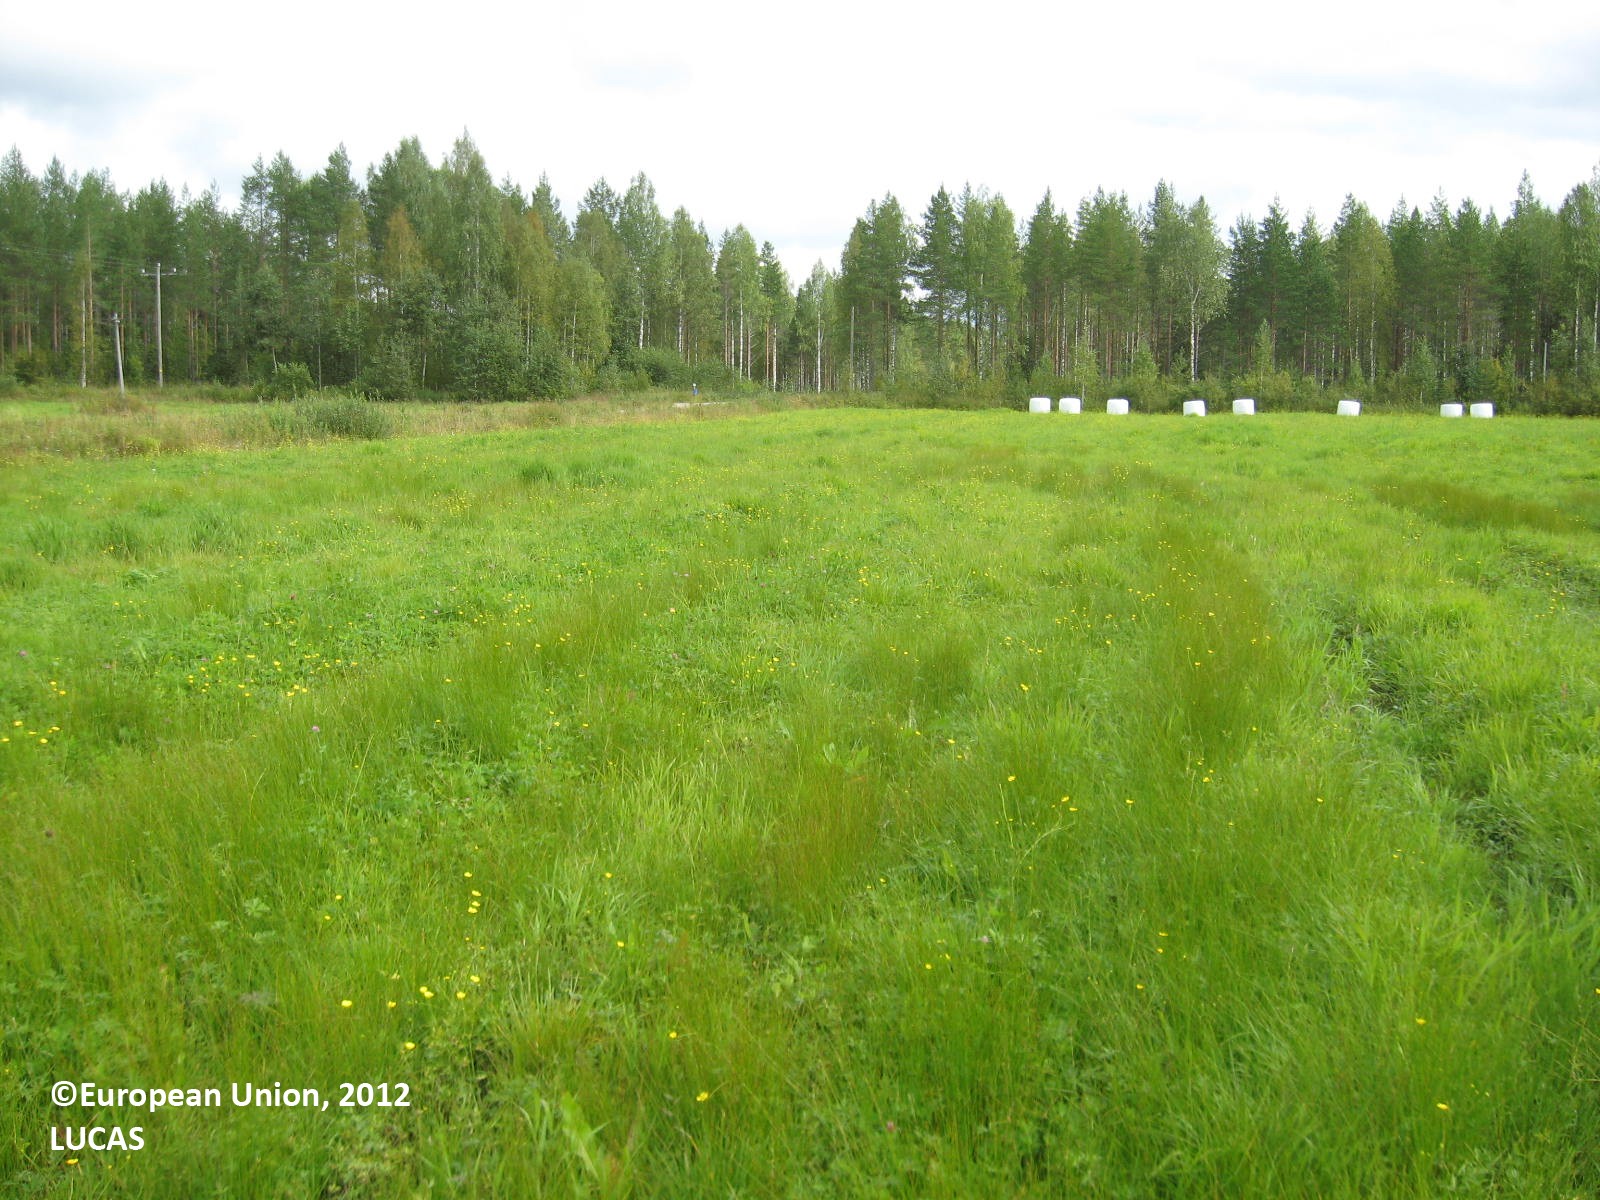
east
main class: Cropland
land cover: Temporary grasslands
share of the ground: > 75 %
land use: Agriculture (excluding fallow land and kitchen gardens)
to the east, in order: Temporary grasslands; Grass margins; Shruby margins; Paved roads, cycling and walking lanes; Shruby margins; Grass margins; Temporary grasslands; Shruby margins; Ditches and canals; Grass margins; Paved roads, cycling and walking lanes; Grass margins; Ditches and canals; Electric lines; Other mixed woodland; Electric lines; Other mixed woodland
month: August
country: FI
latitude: 63.5917
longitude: 29.2605
